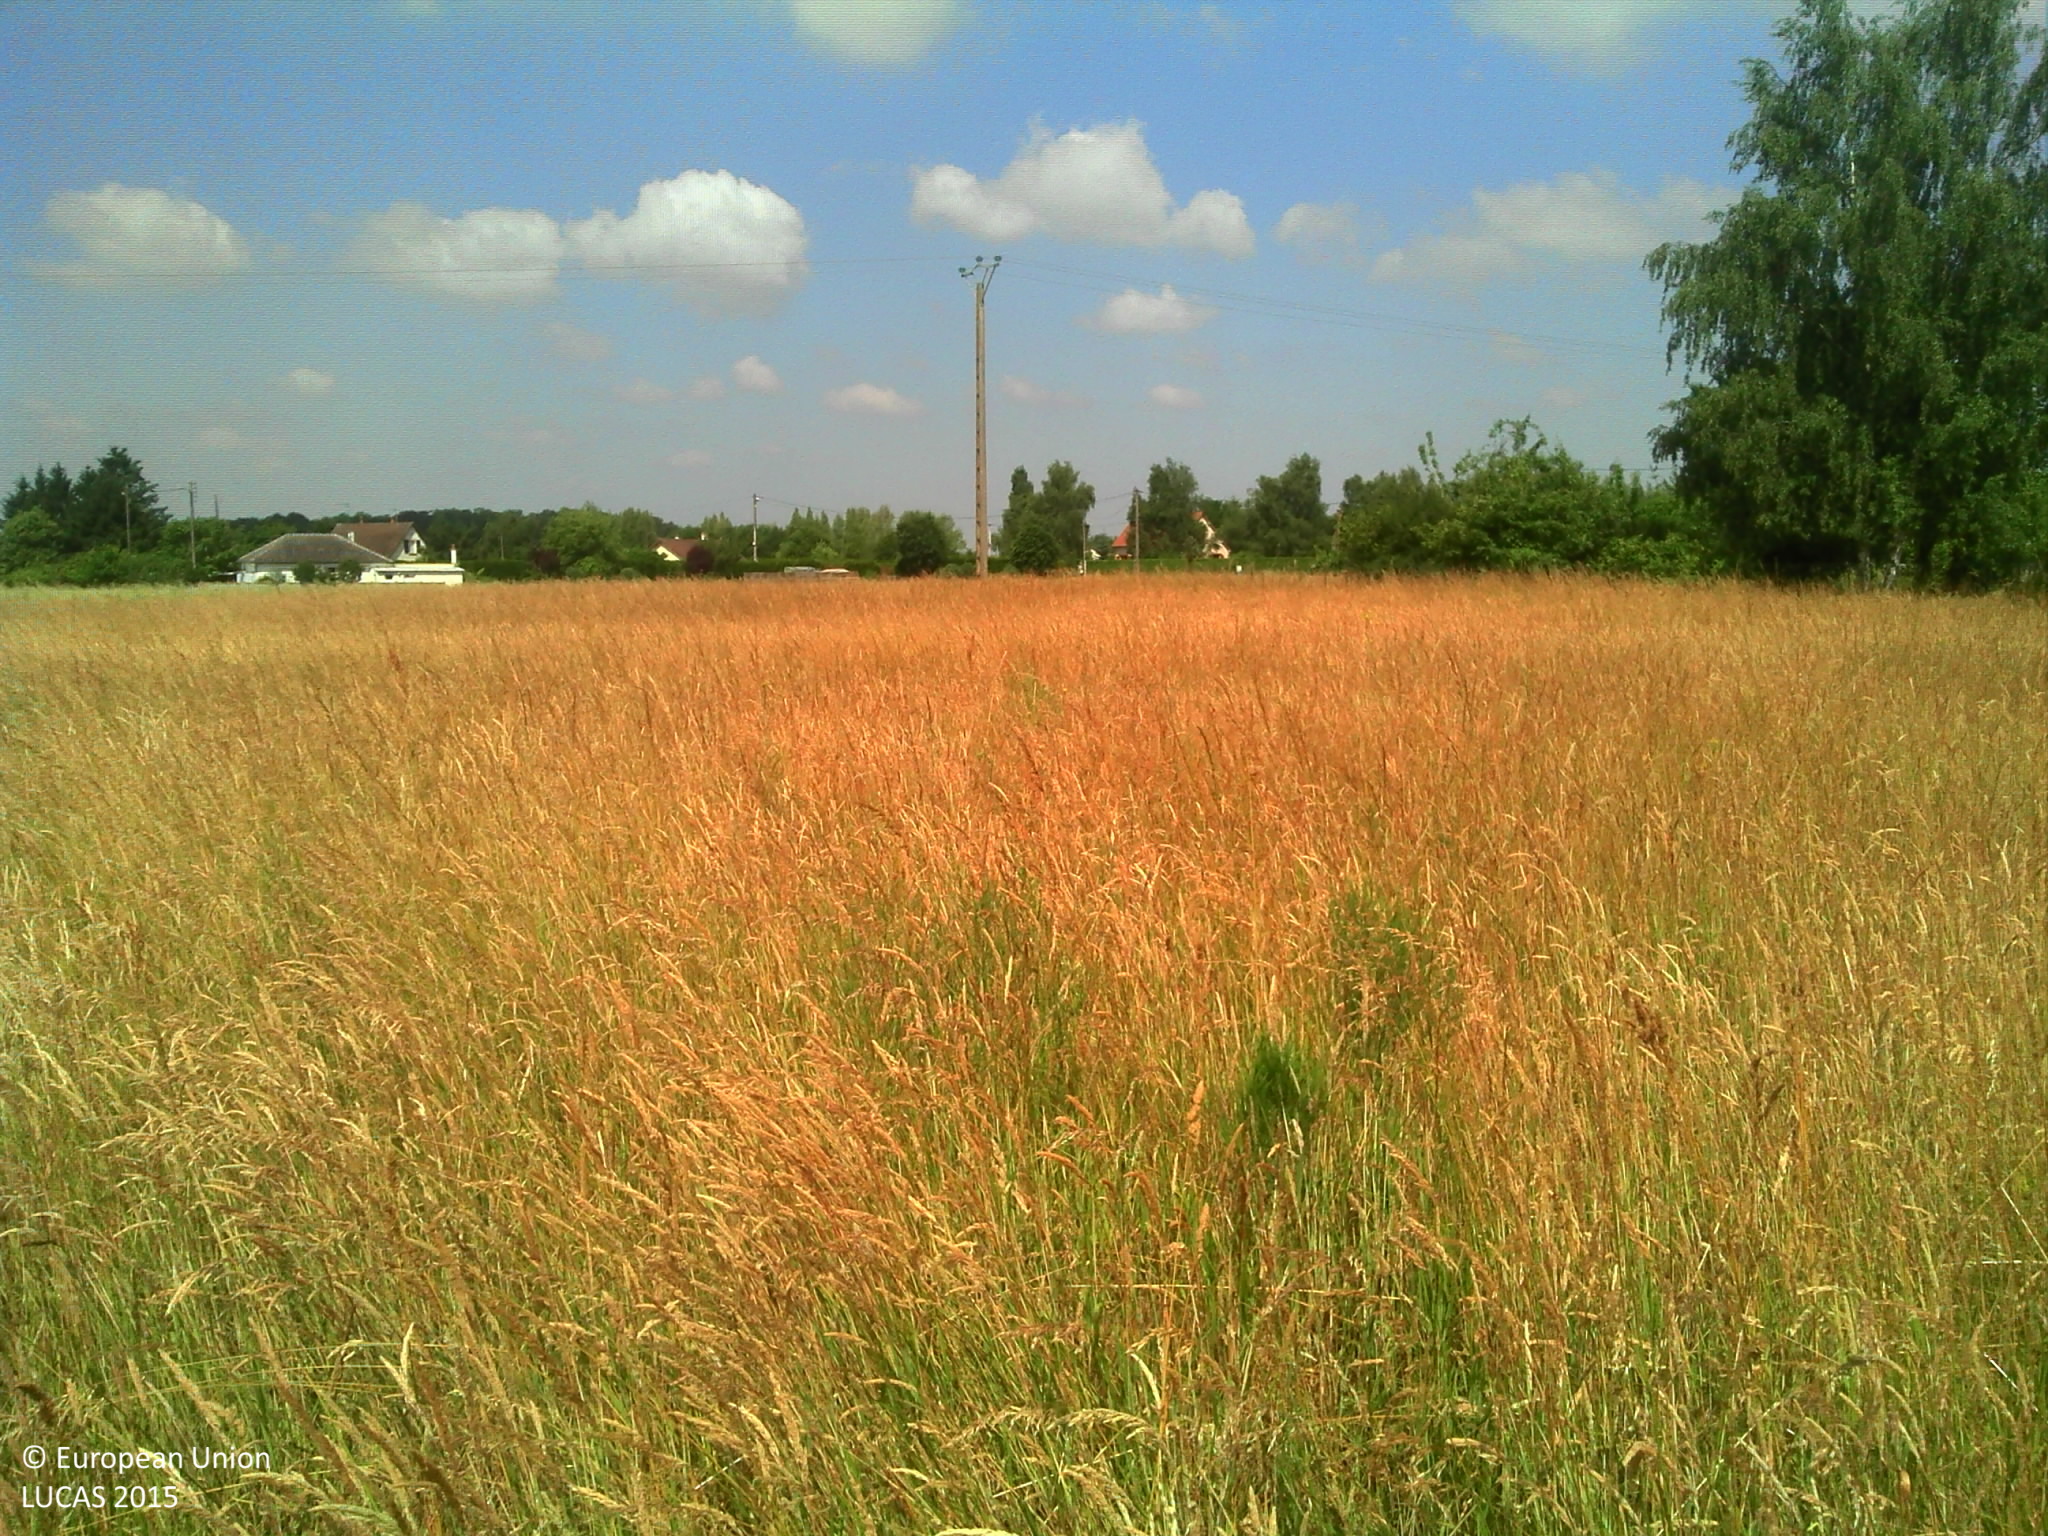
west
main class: Grassland
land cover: Grassland without tree/shrub cover
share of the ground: > 75 %
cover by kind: herbaceous plants 100 %
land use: Agriculture (excluding fallow land and kitchen gardens)
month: June
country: FR
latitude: 47.6022
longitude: 1.4596
